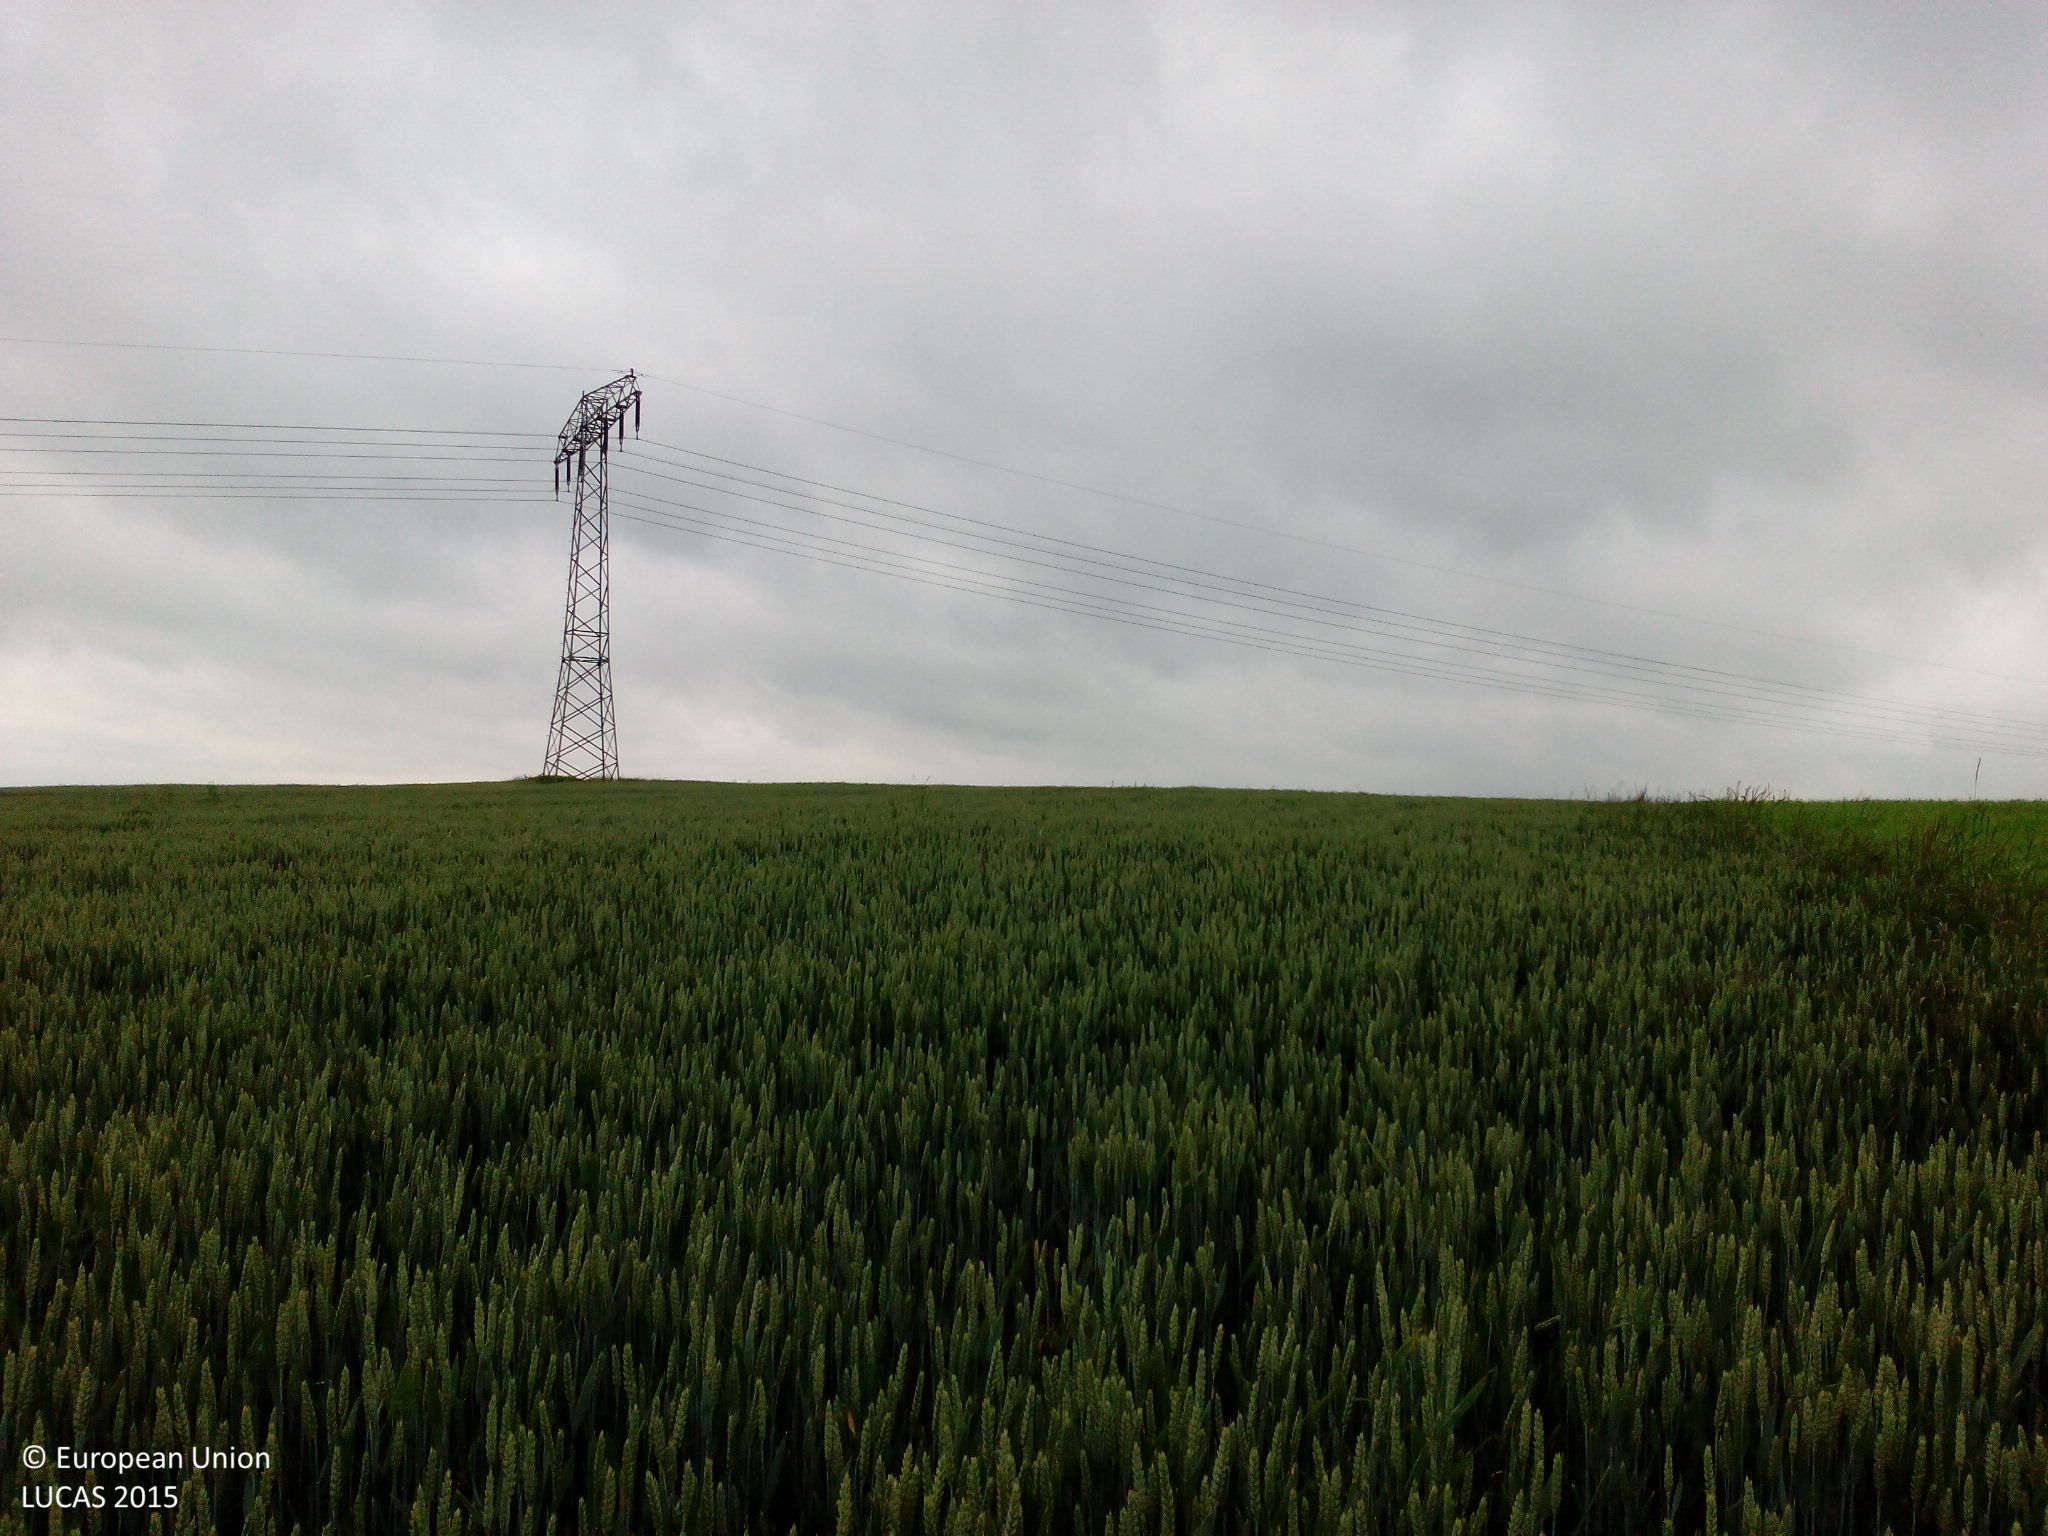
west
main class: Cropland
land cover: Common wheat
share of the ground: > 75 %
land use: Agriculture (excluding fallow land and kitchen gardens)
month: June
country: DE
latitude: 51.0958
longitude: 13.0987
